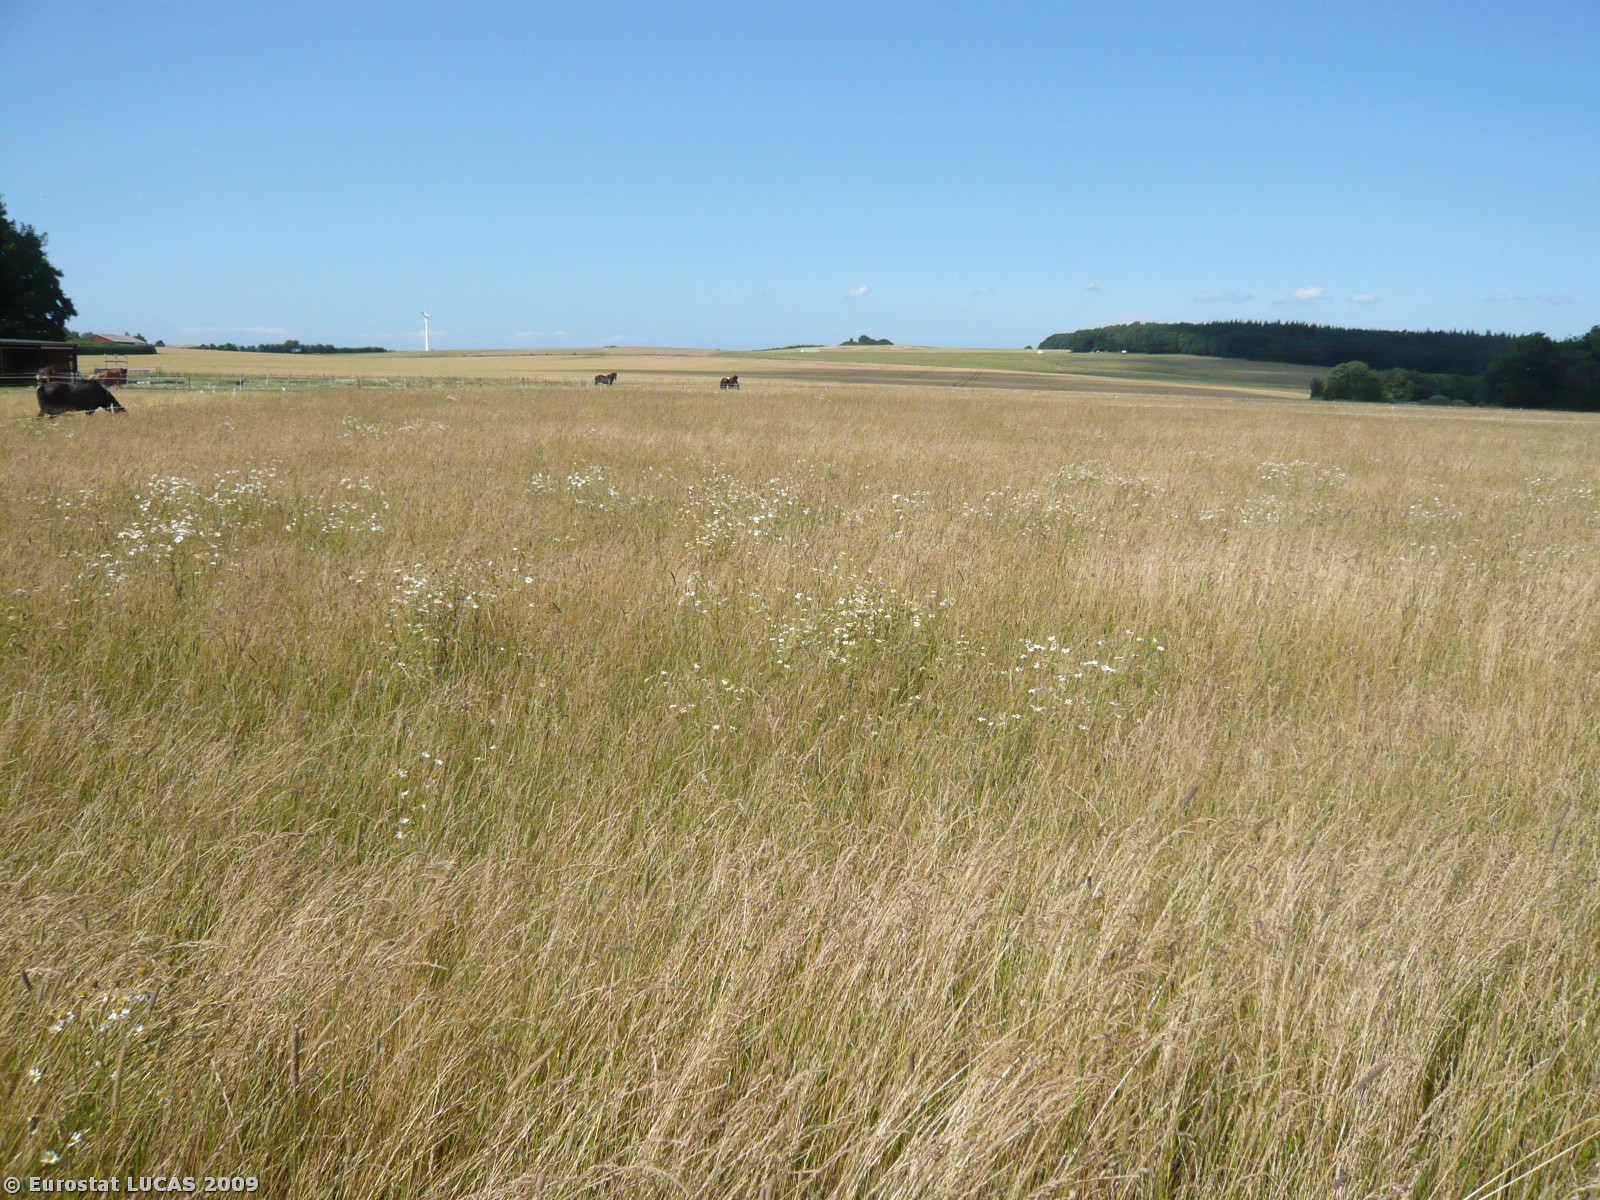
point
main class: Grassland
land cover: Grassland without tree/shrub cover
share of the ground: > 75 %
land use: Agriculture (excluding fallow land and kitchen gardens)
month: July
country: DK
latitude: 55.7625
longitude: 11.7355
